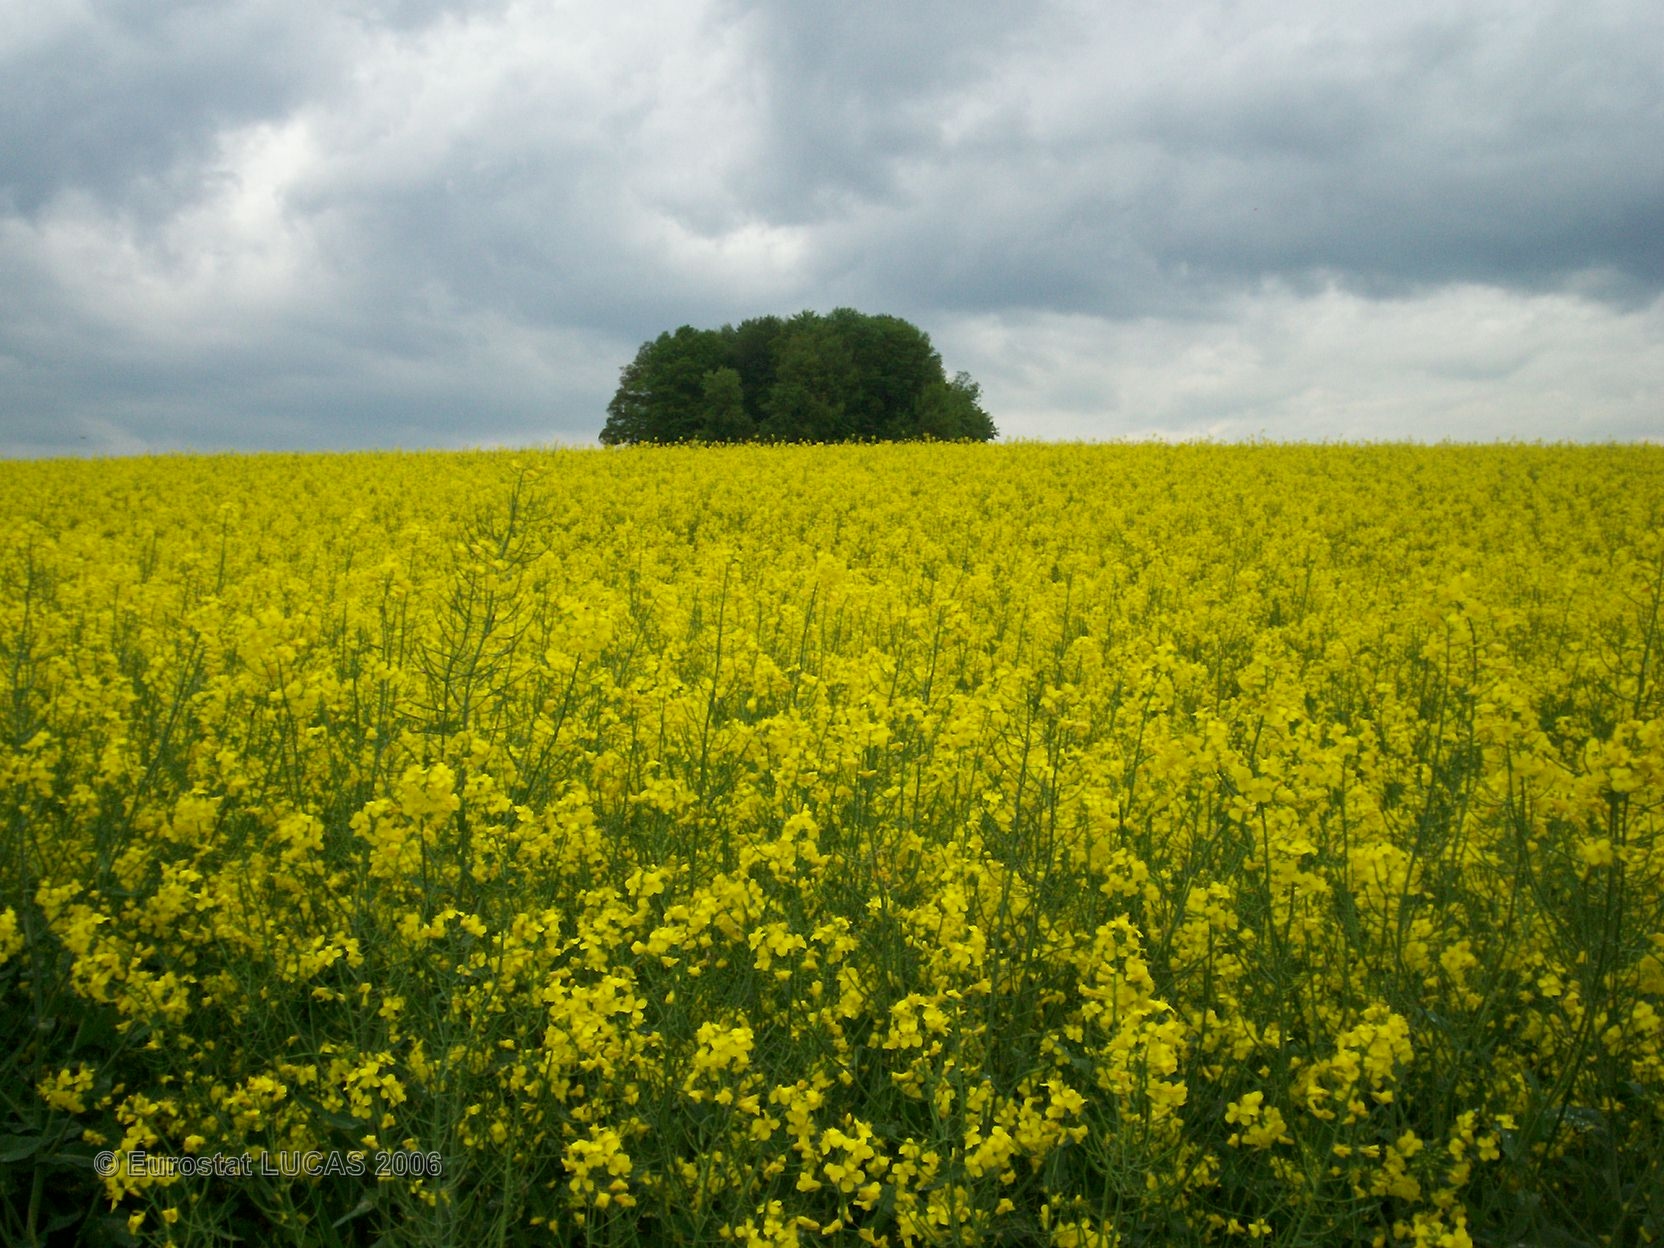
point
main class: Cropland
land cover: Rape and turnip rape
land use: Agriculture (excluding fallow land and kitchen gardens)
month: May
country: FR
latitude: 48.6555
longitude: 6.5387
